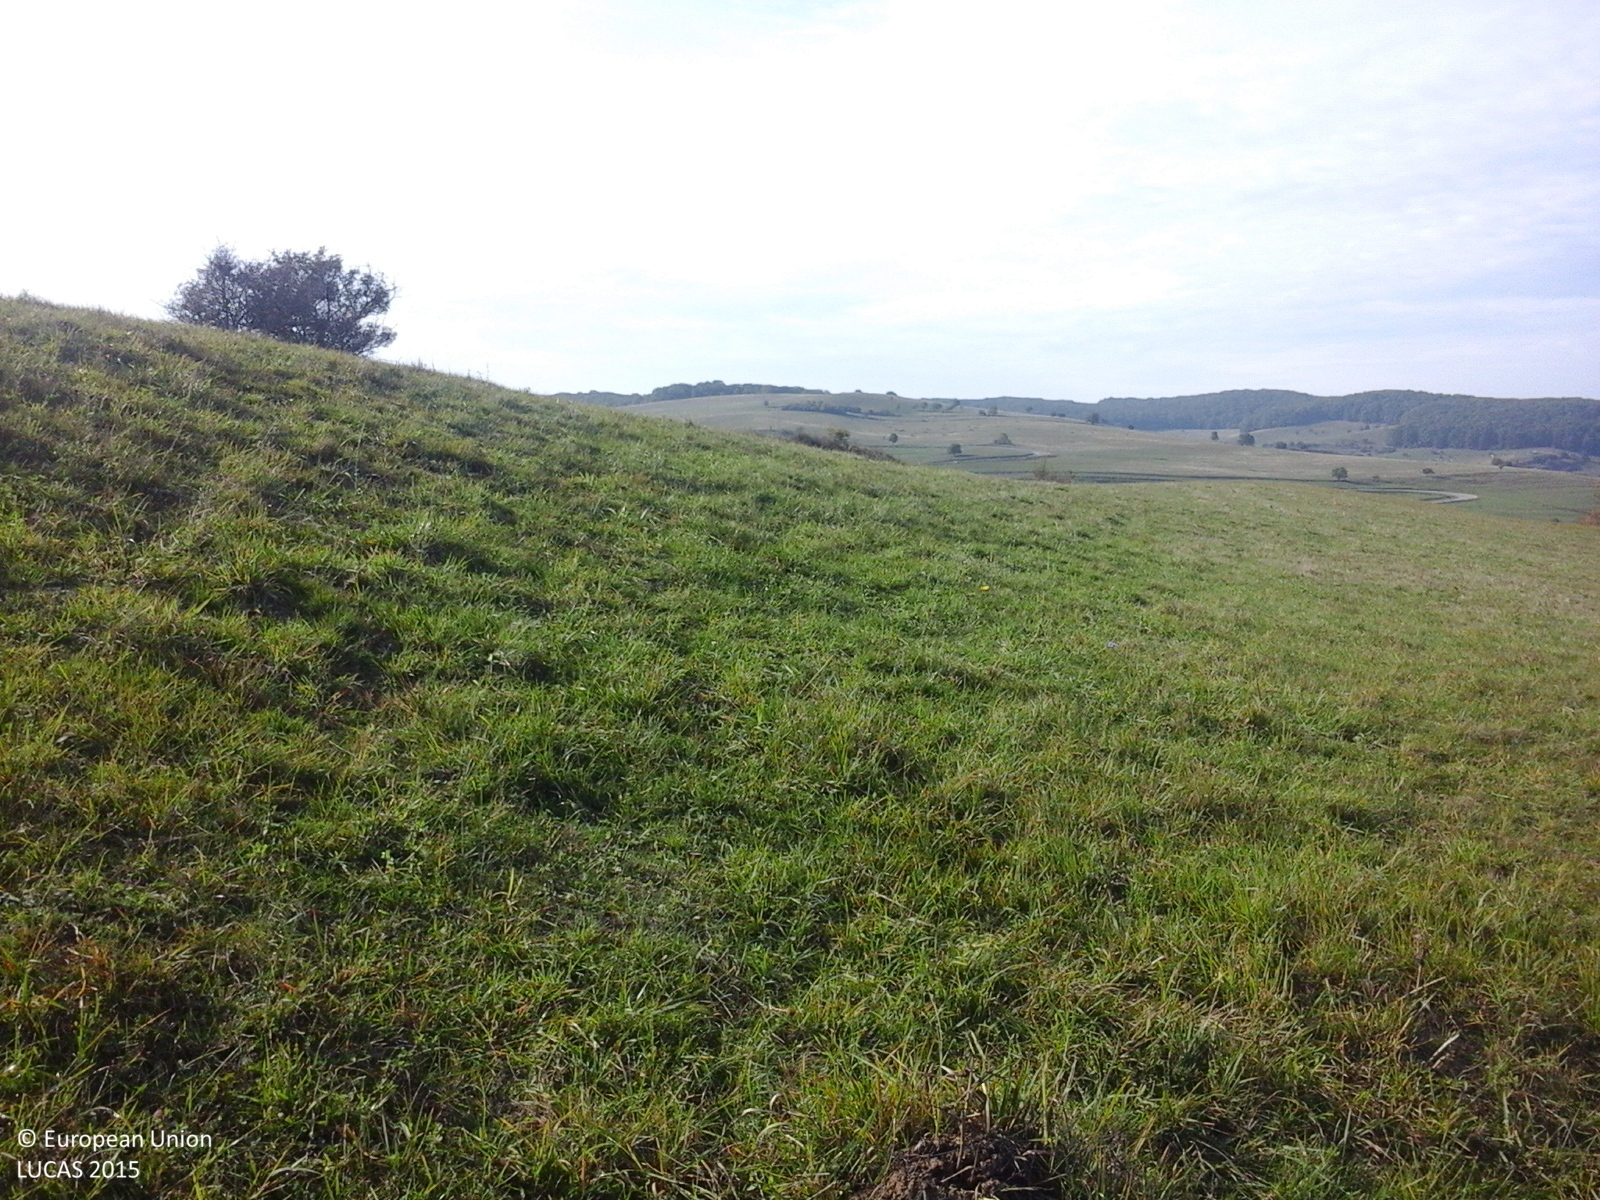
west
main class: Grassland
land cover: Grassland without tree/shrub cover
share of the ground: > 75 %
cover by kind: herbaceous plants 100 %
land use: Agriculture (excluding fallow land and kitchen gardens)
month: October
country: RO
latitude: 45.9497
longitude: 24.9672
